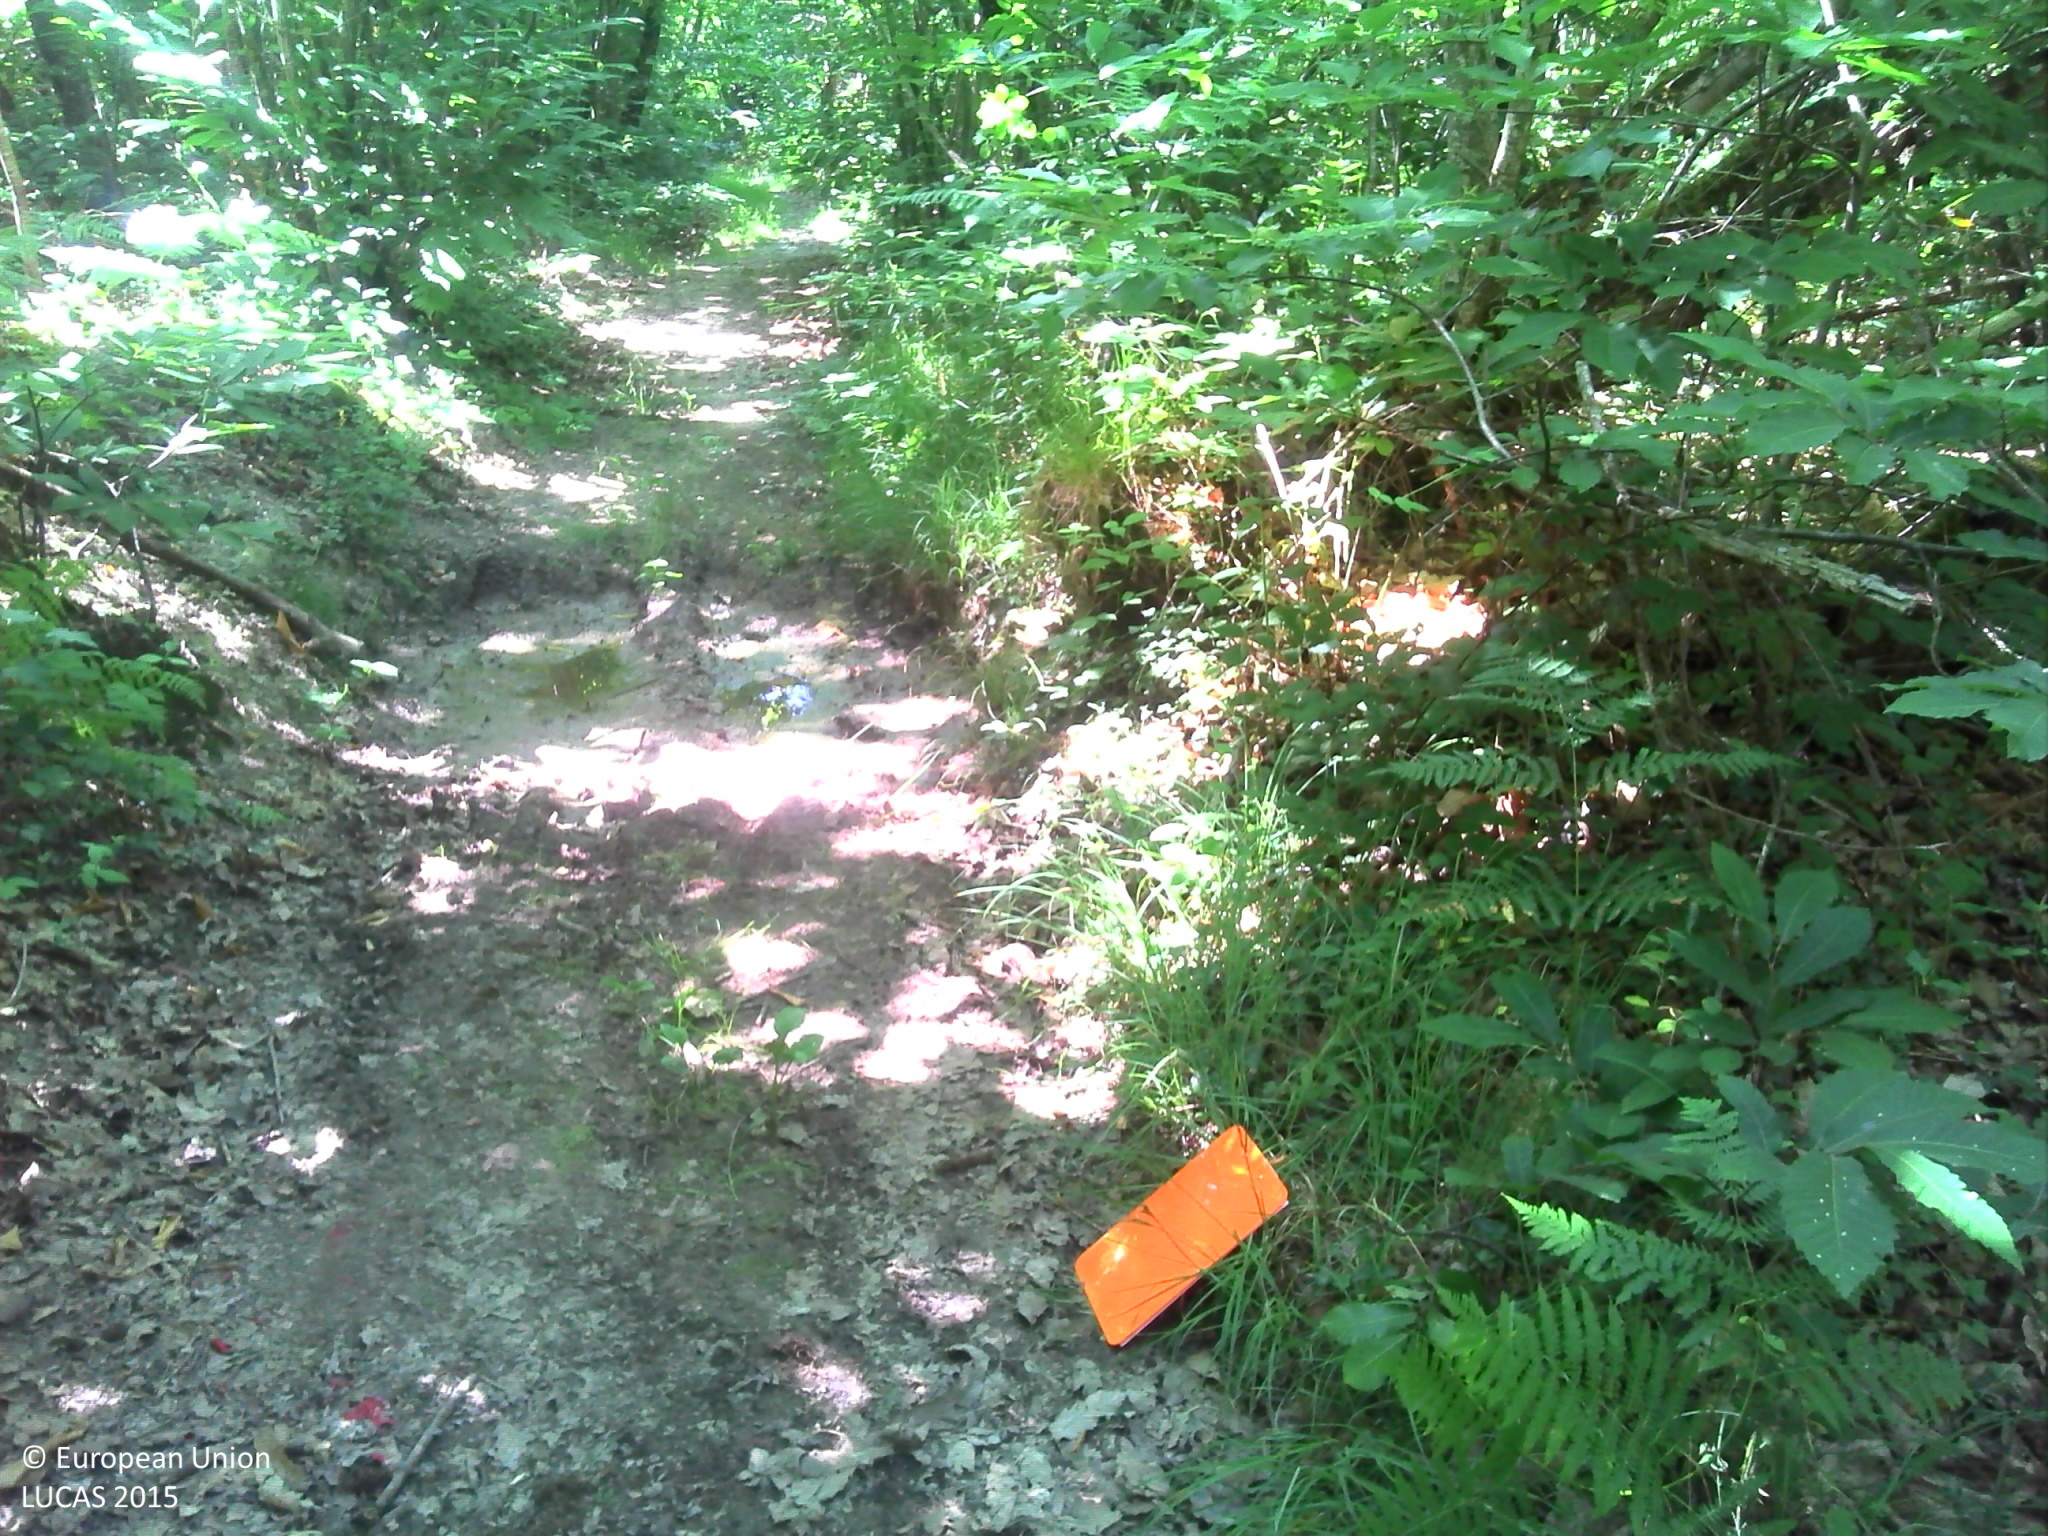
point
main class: Woodland
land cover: Broadleaved woodland
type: thermophilous deciduous forest
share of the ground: > 75 %
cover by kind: broadleaved forest trees 100 %
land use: Forestry
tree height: > 5 m
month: June
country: FR
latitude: 45.6228
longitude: -0.6043
